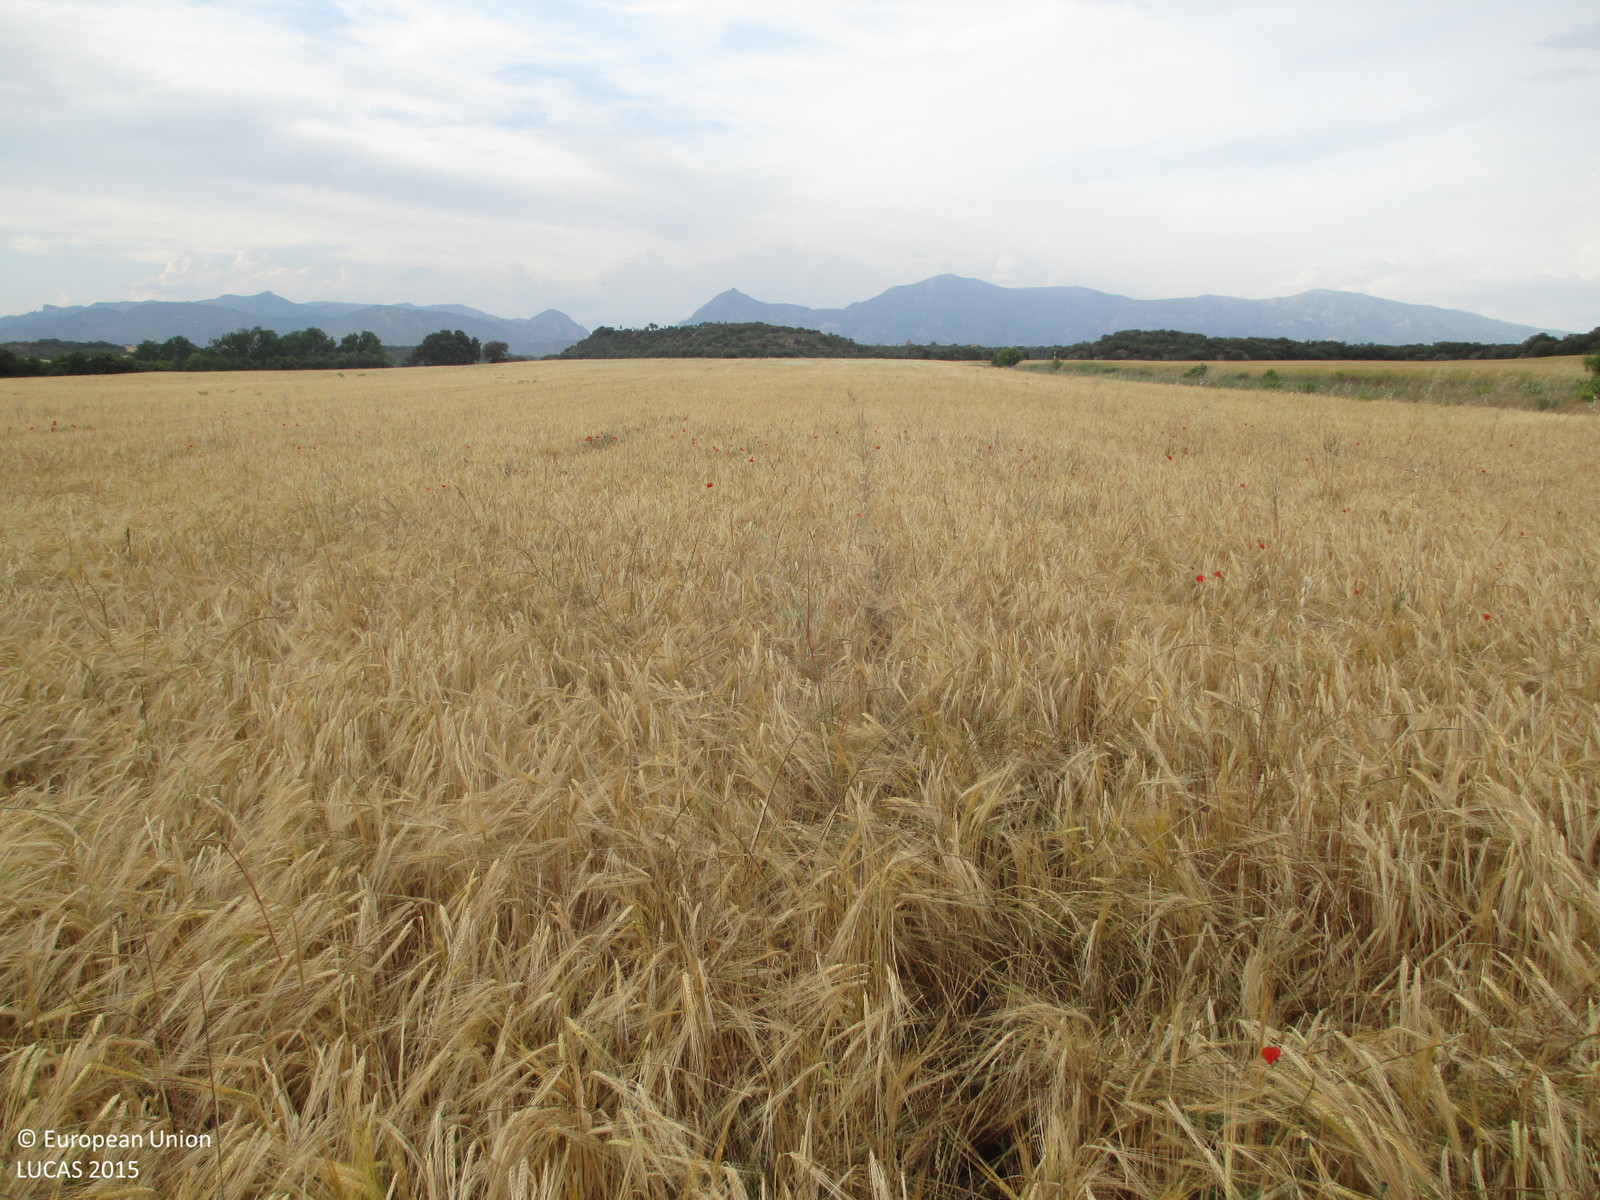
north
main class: Cropland
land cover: Barley
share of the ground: > 75 %
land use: Agriculture (excluding fallow land and kitchen gardens)
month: May
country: ES
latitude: 42.1308
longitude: -0.2682
